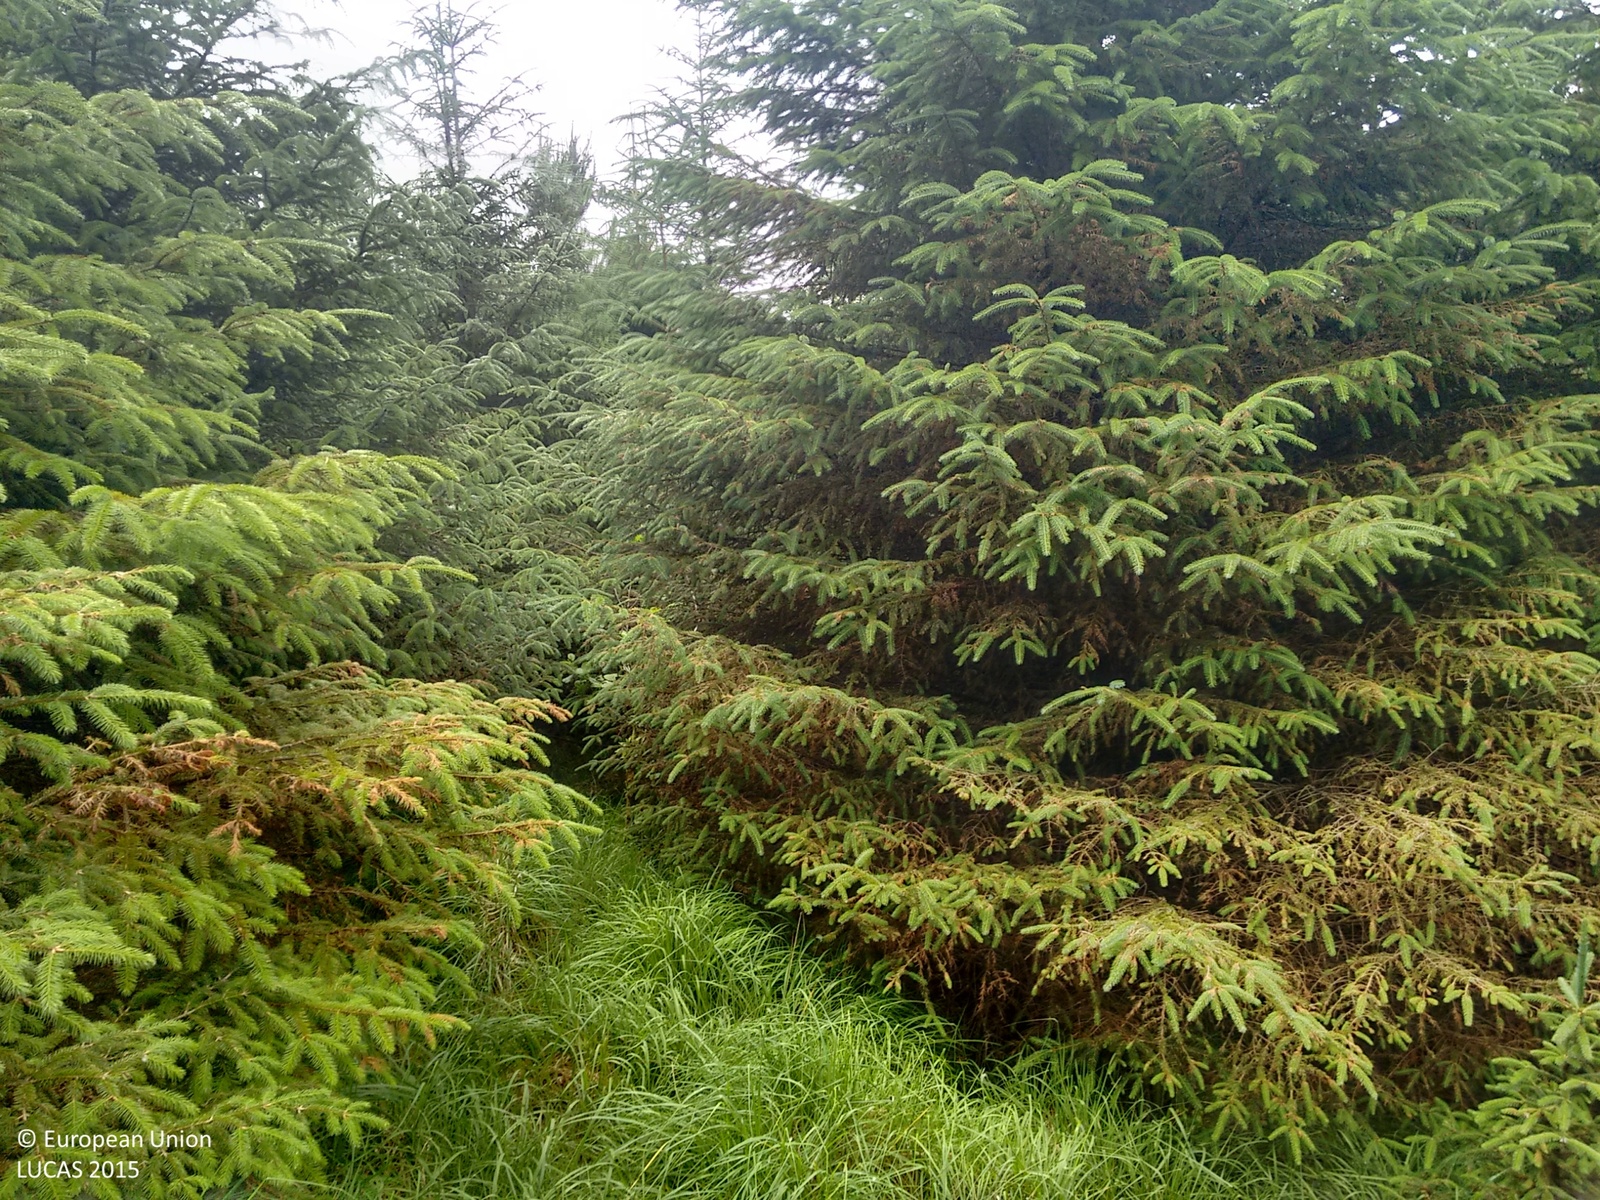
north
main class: Woodland
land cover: Spruce dominated coniferous woodland
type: exotic forest
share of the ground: > 75 %
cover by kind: coniferous forest trees 95 %, herbaceous plants 5 %
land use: Forestry
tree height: > 5 m
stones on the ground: < 10 %
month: July
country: IE
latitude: 52.0337
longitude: -8.9419
